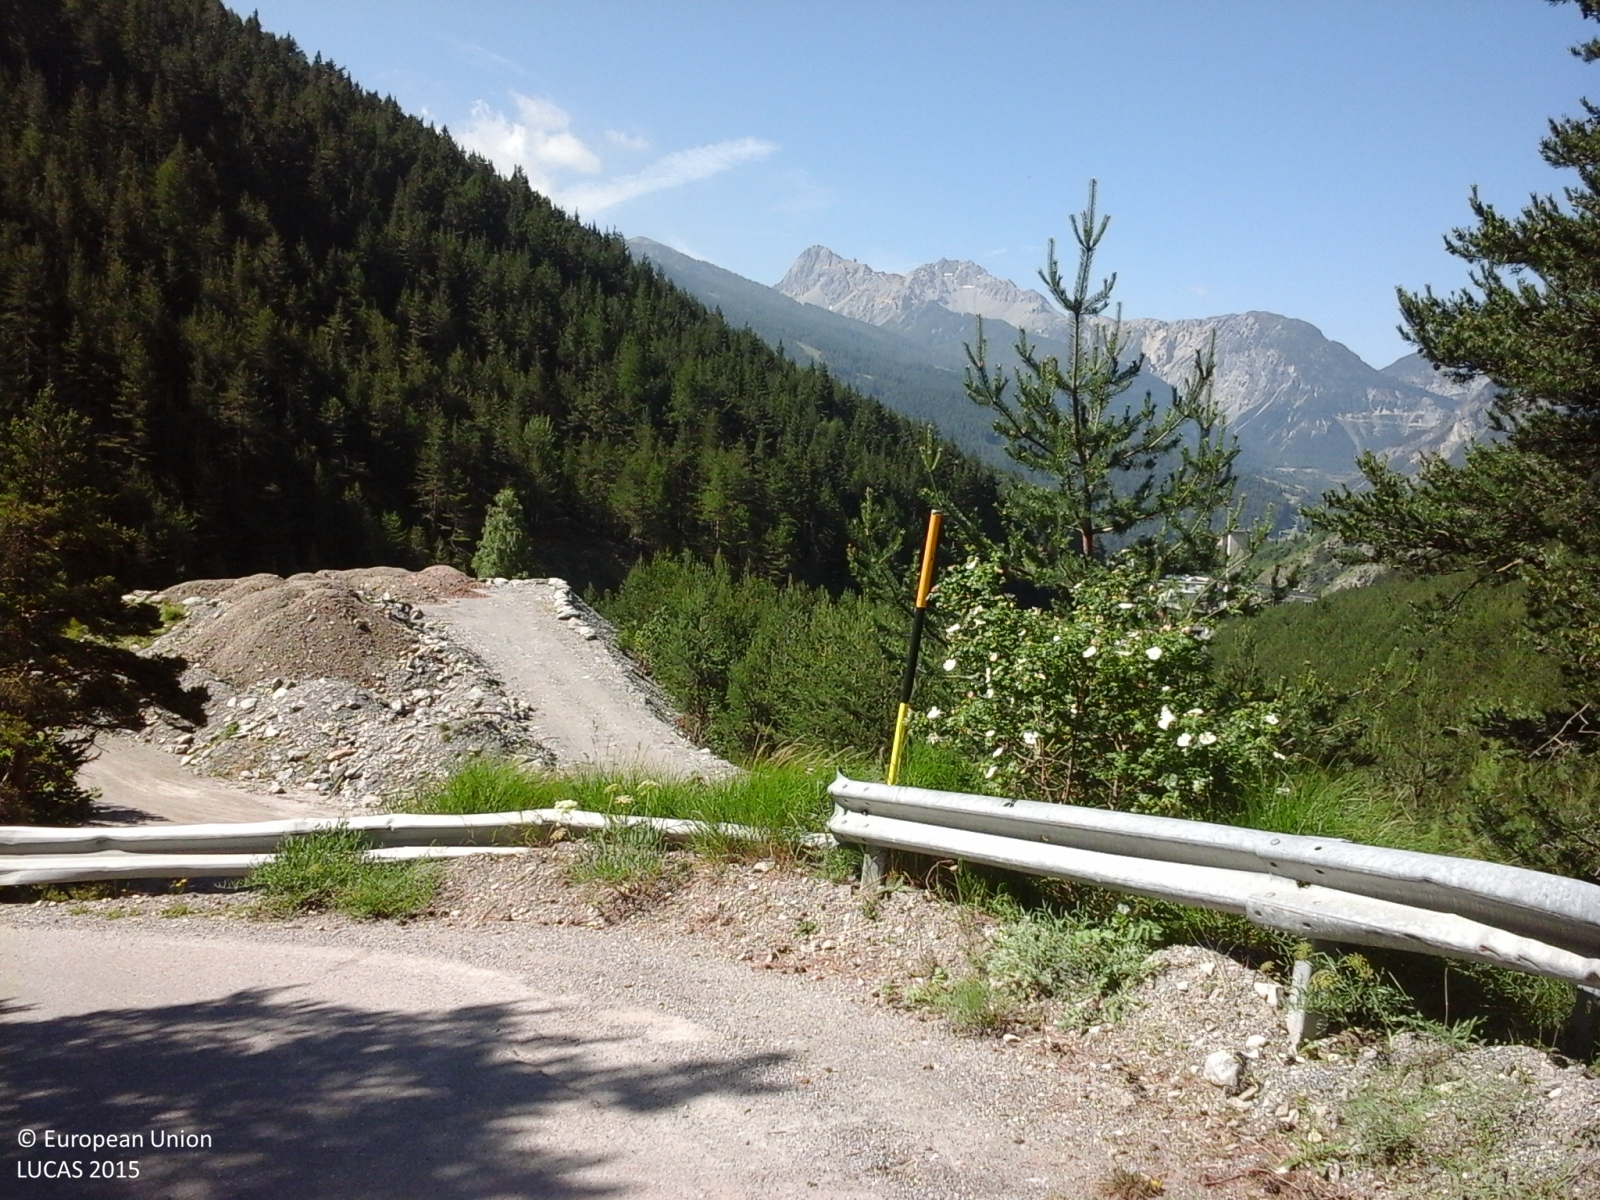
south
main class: Shrubland
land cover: Shrubland without tree cover
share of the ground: 10 - 25 %
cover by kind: herbaceous plants 40 %, consolidated bare surface 40 %, shrubs 20 %
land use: Semi-natural and natural areas not in use
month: June
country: IT
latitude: 45.0925
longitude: 6.7142
